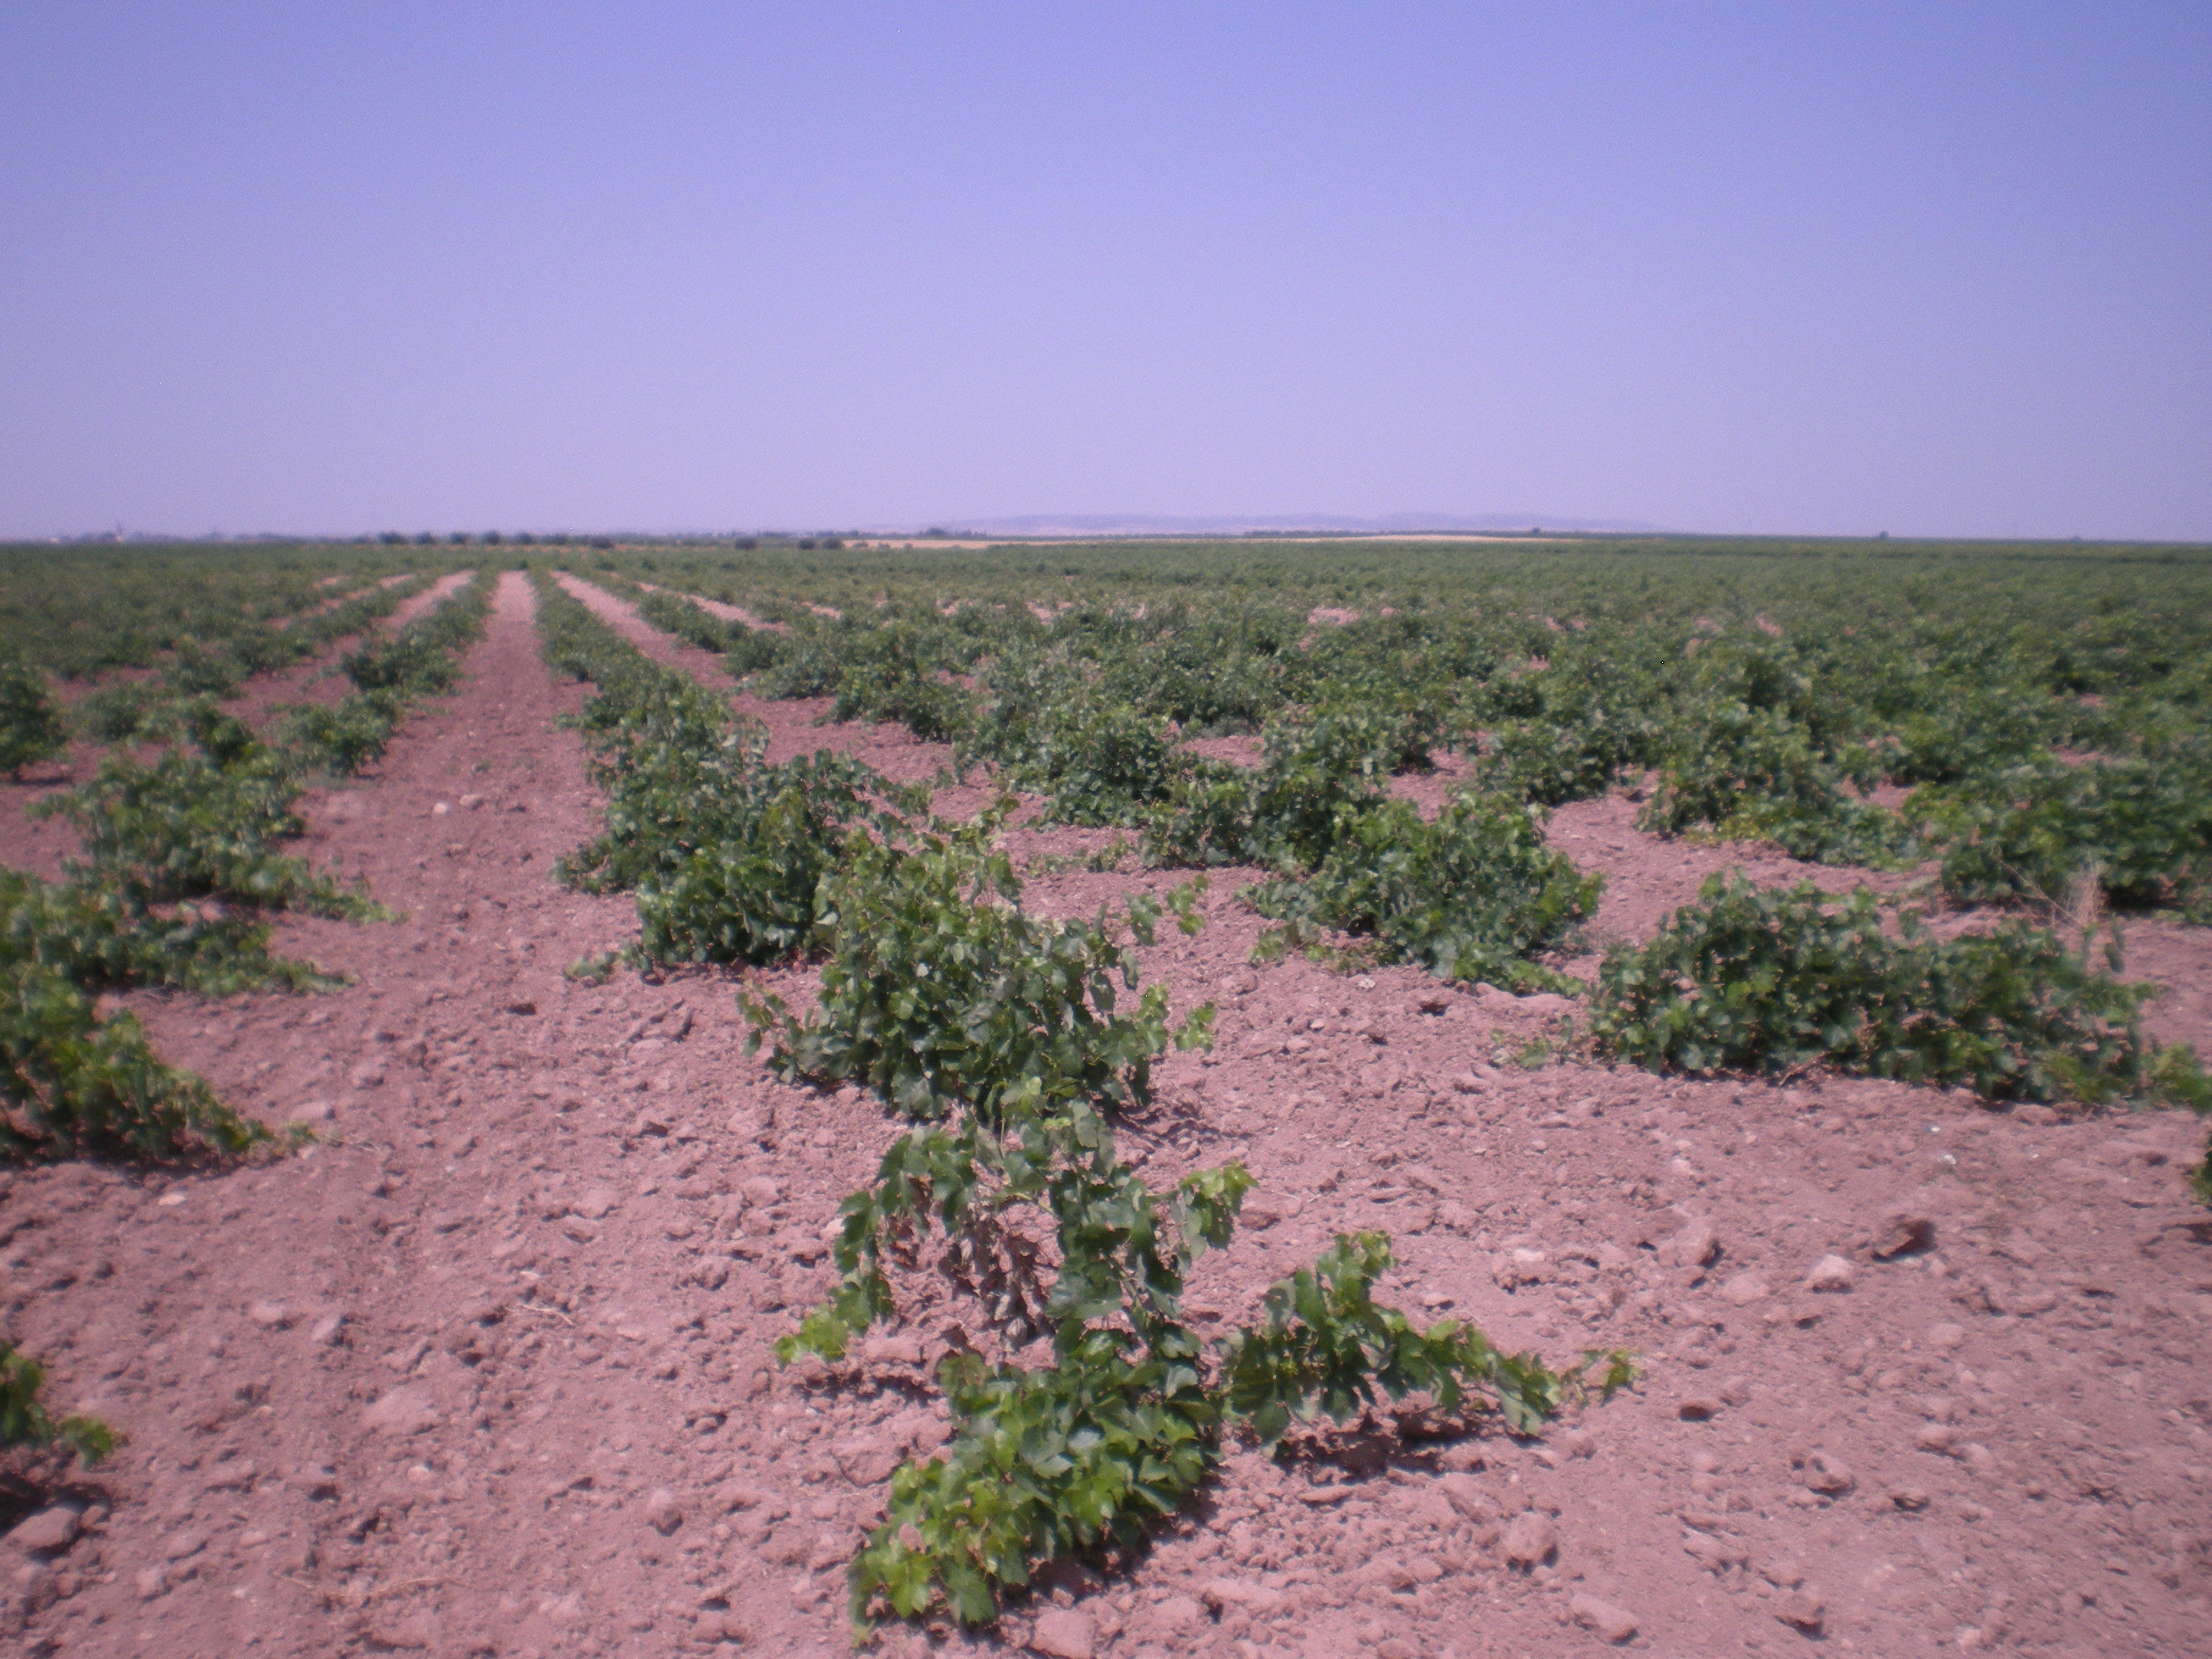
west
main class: Cropland
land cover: Vineyards
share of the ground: 10 - 25 %
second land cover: Other bare soil
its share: > 75 %
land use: Agriculture (excluding fallow land and kitchen gardens)
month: June
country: ES
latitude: 39.6310
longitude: -3.1745
